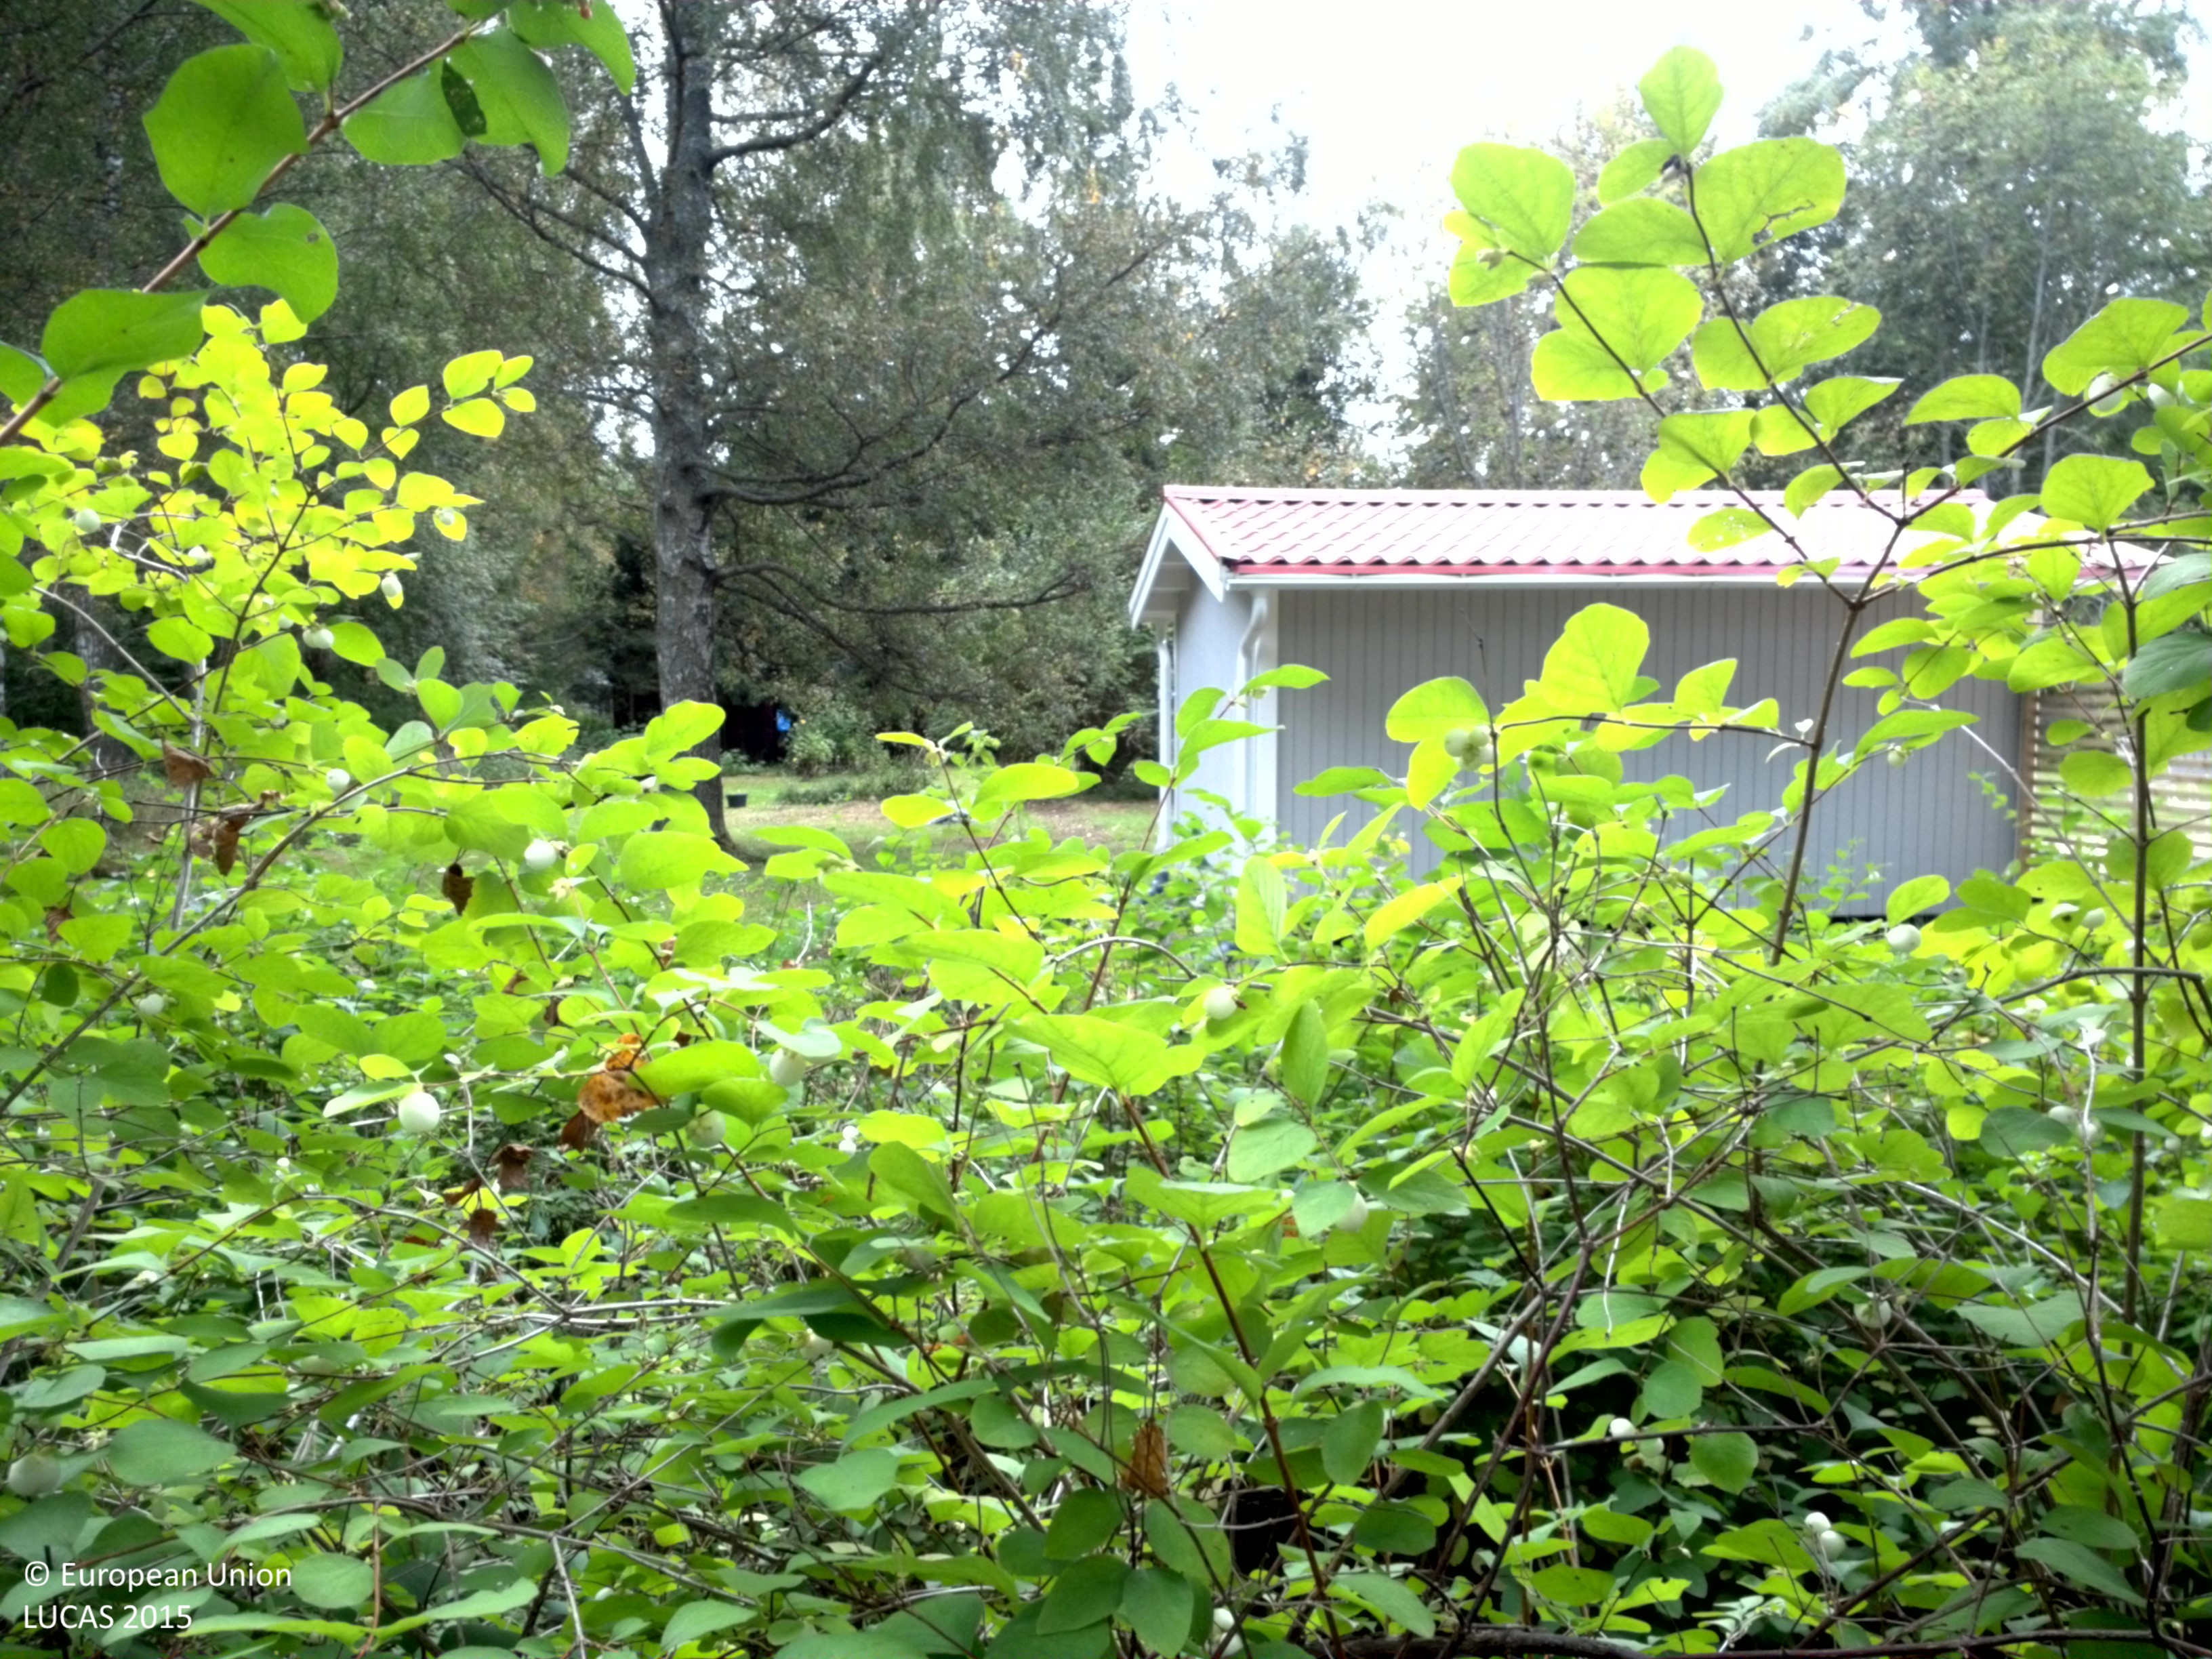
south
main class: Woodland
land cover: Broadleaved woodland
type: boreal forest
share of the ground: 50 - 75 %
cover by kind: broadleaved forest trees 65 %, shrubs 20 %, coniferous forest trees 10 %, herbaceous plants 5 %
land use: Amenities, museums, leisure
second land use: Residential
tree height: > 5 m
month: September
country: SE
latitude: 59.2376
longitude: 18.4674
